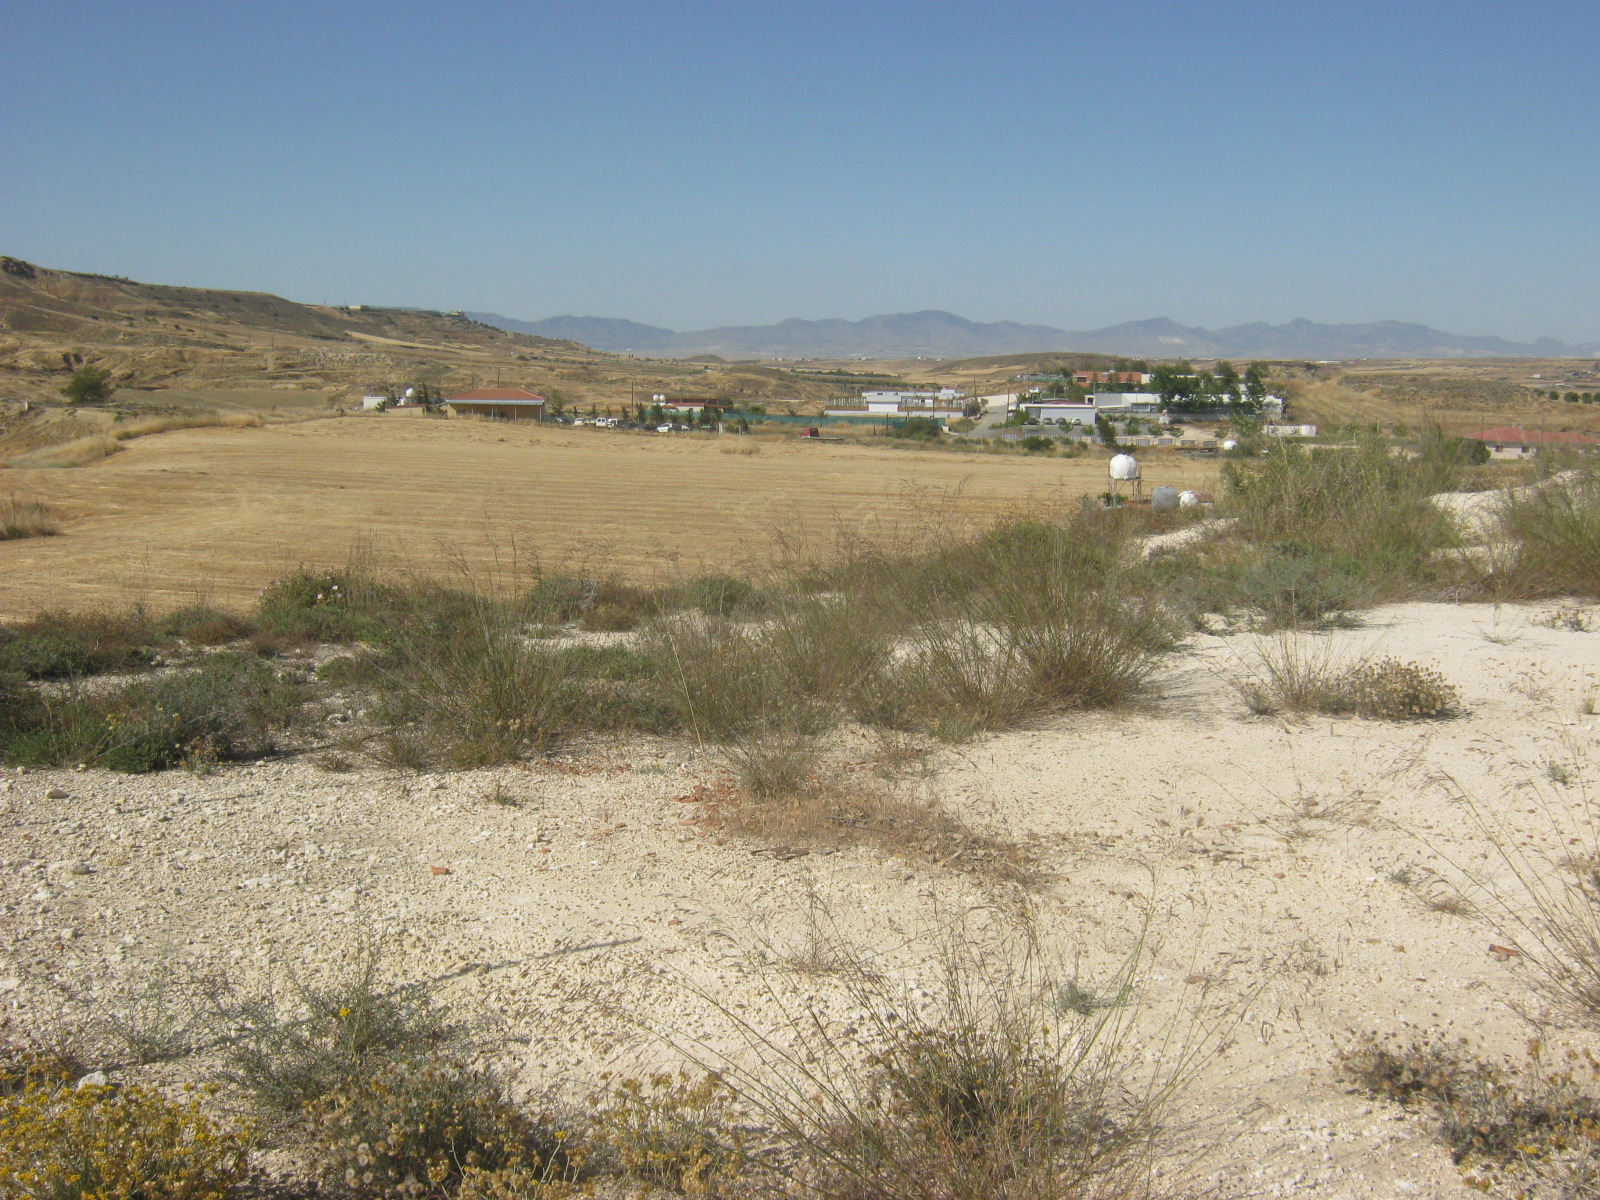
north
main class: Grassland
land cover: Spontaneously vegetated surfaces
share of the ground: > 75 %
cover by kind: herbaceous plants 75 %, unconsolidated bare surface 20 %, shrubs 5 %
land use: Agriculture (excluding fallow land and kitchen gardens)
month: May
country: CY
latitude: 35.0617
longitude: 33.1993
